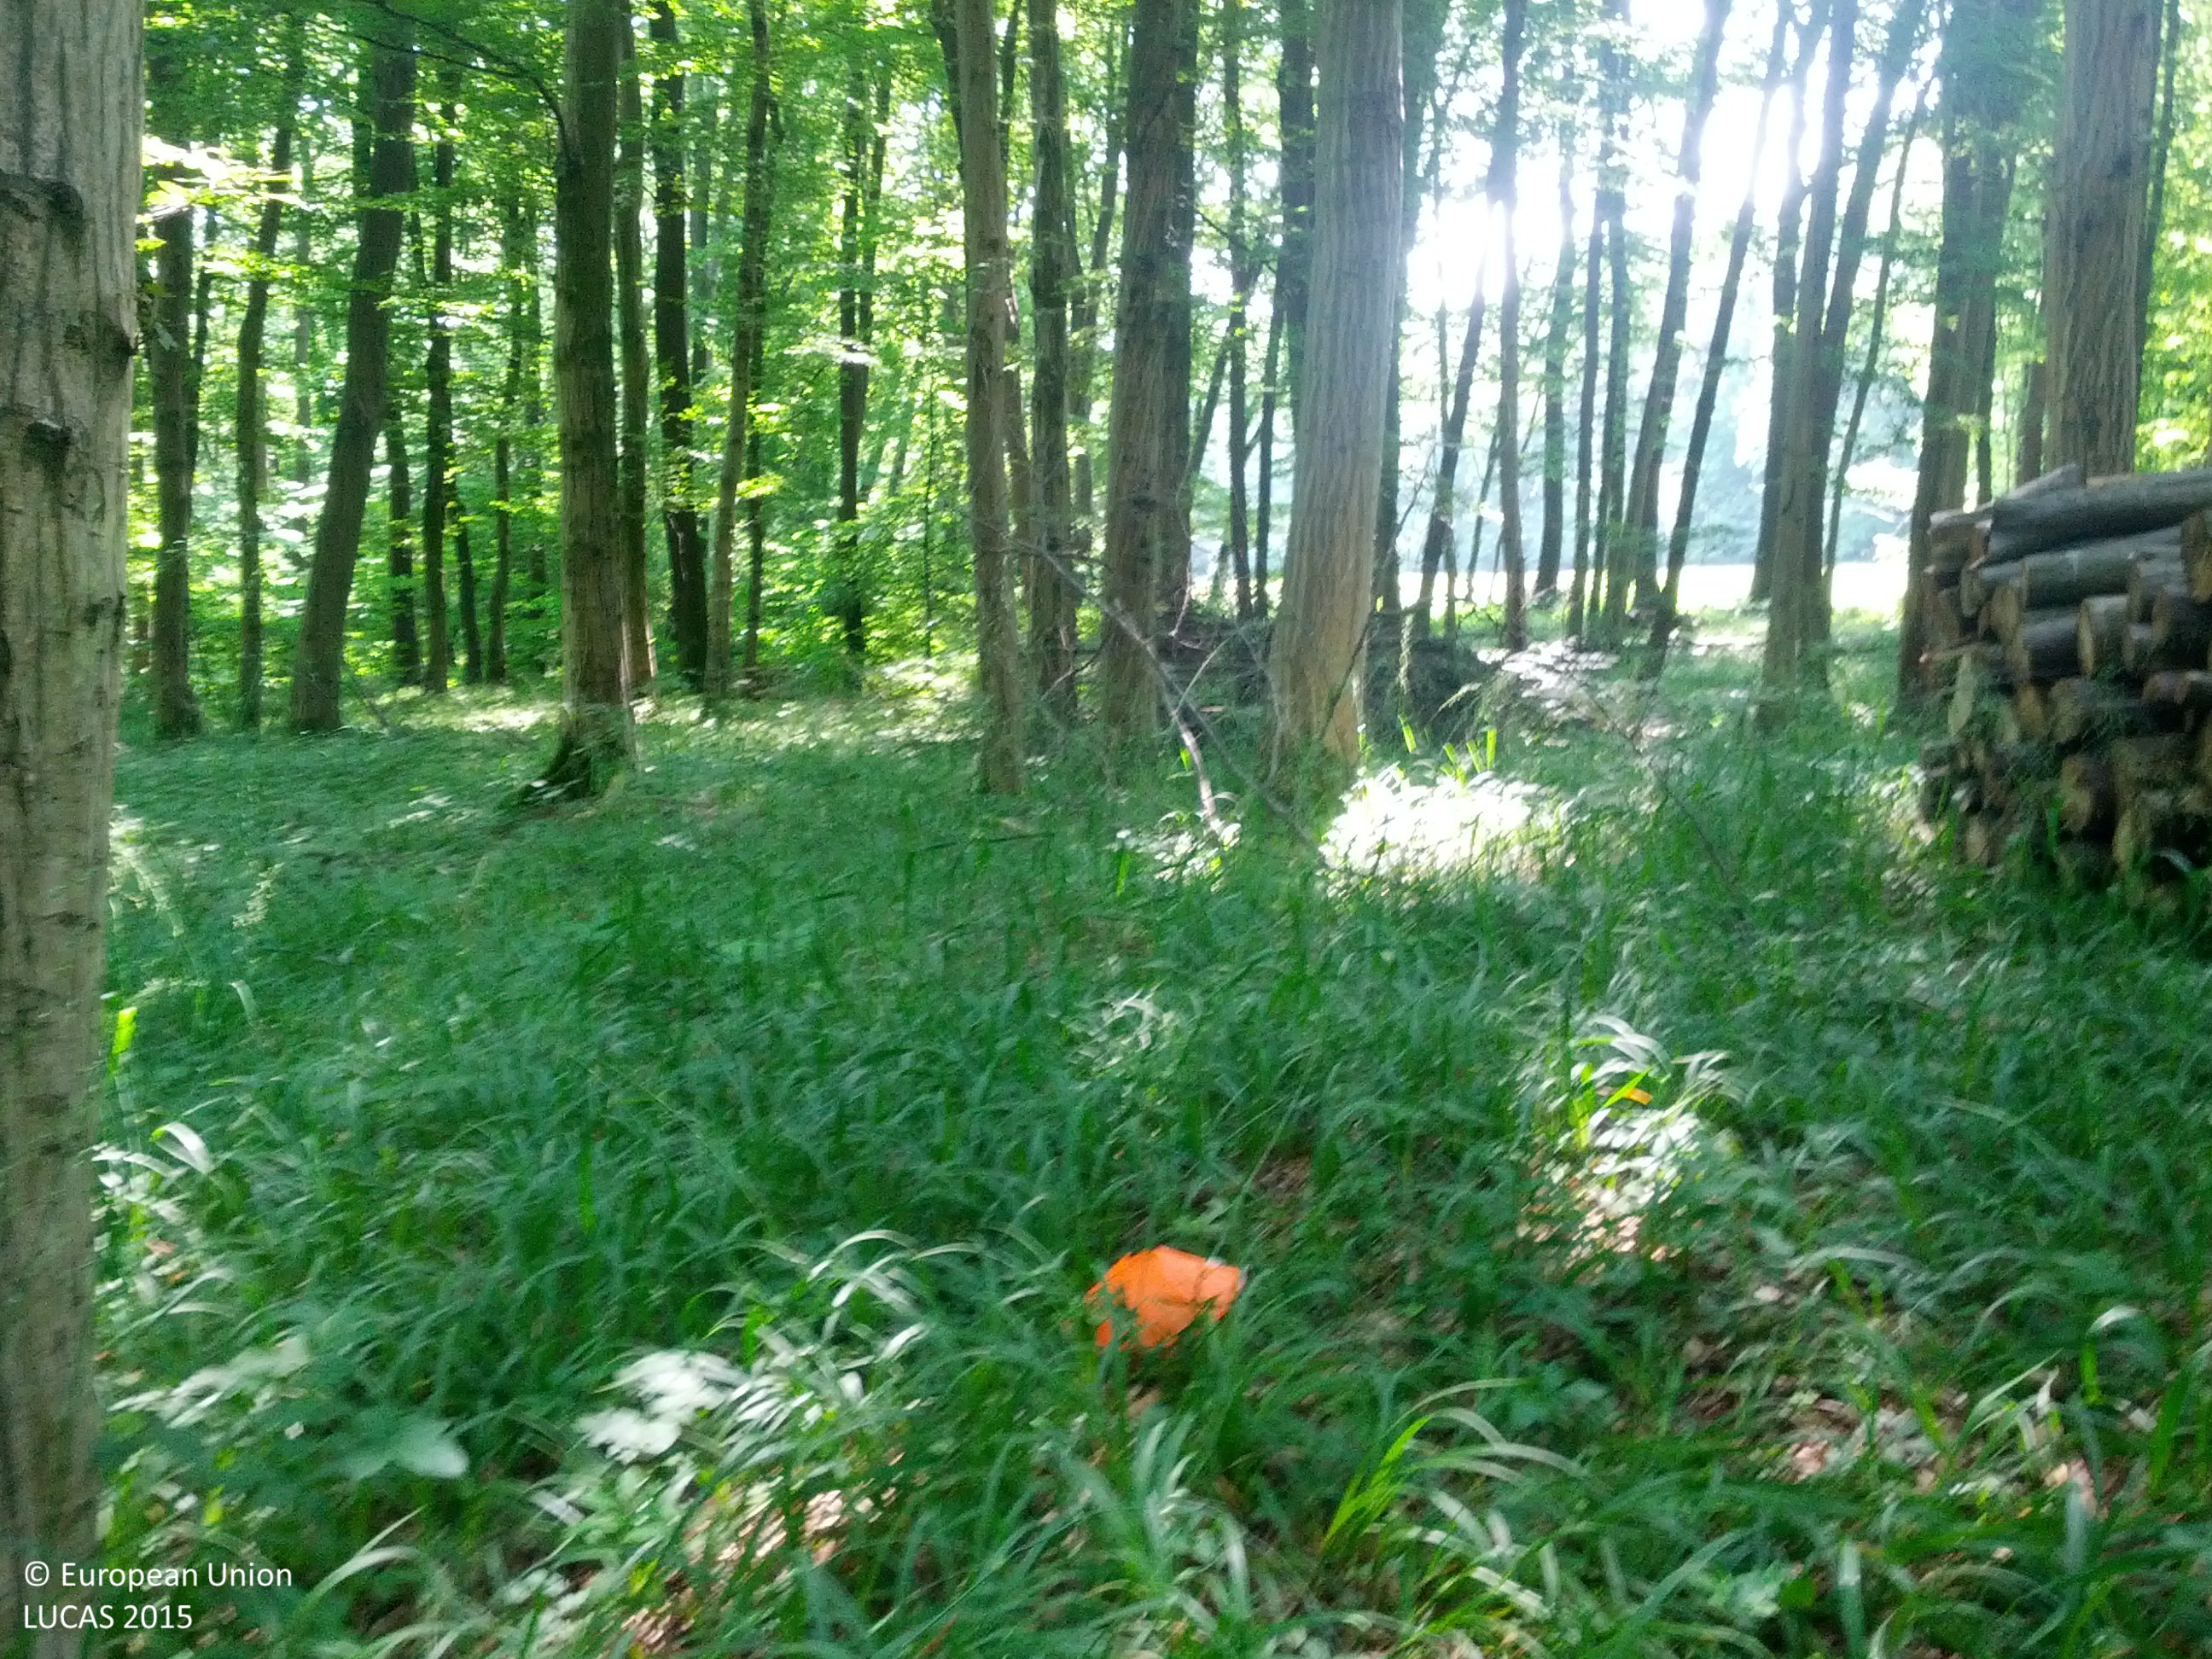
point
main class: Woodland
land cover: Broadleaved woodland
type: beech forest
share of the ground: > 75 %
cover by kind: broadleaved forest trees 80 %, herbaceous plants 20 %
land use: Forestry
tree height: > 5 m
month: May
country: AT
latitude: 48.2274
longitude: 16.2373
